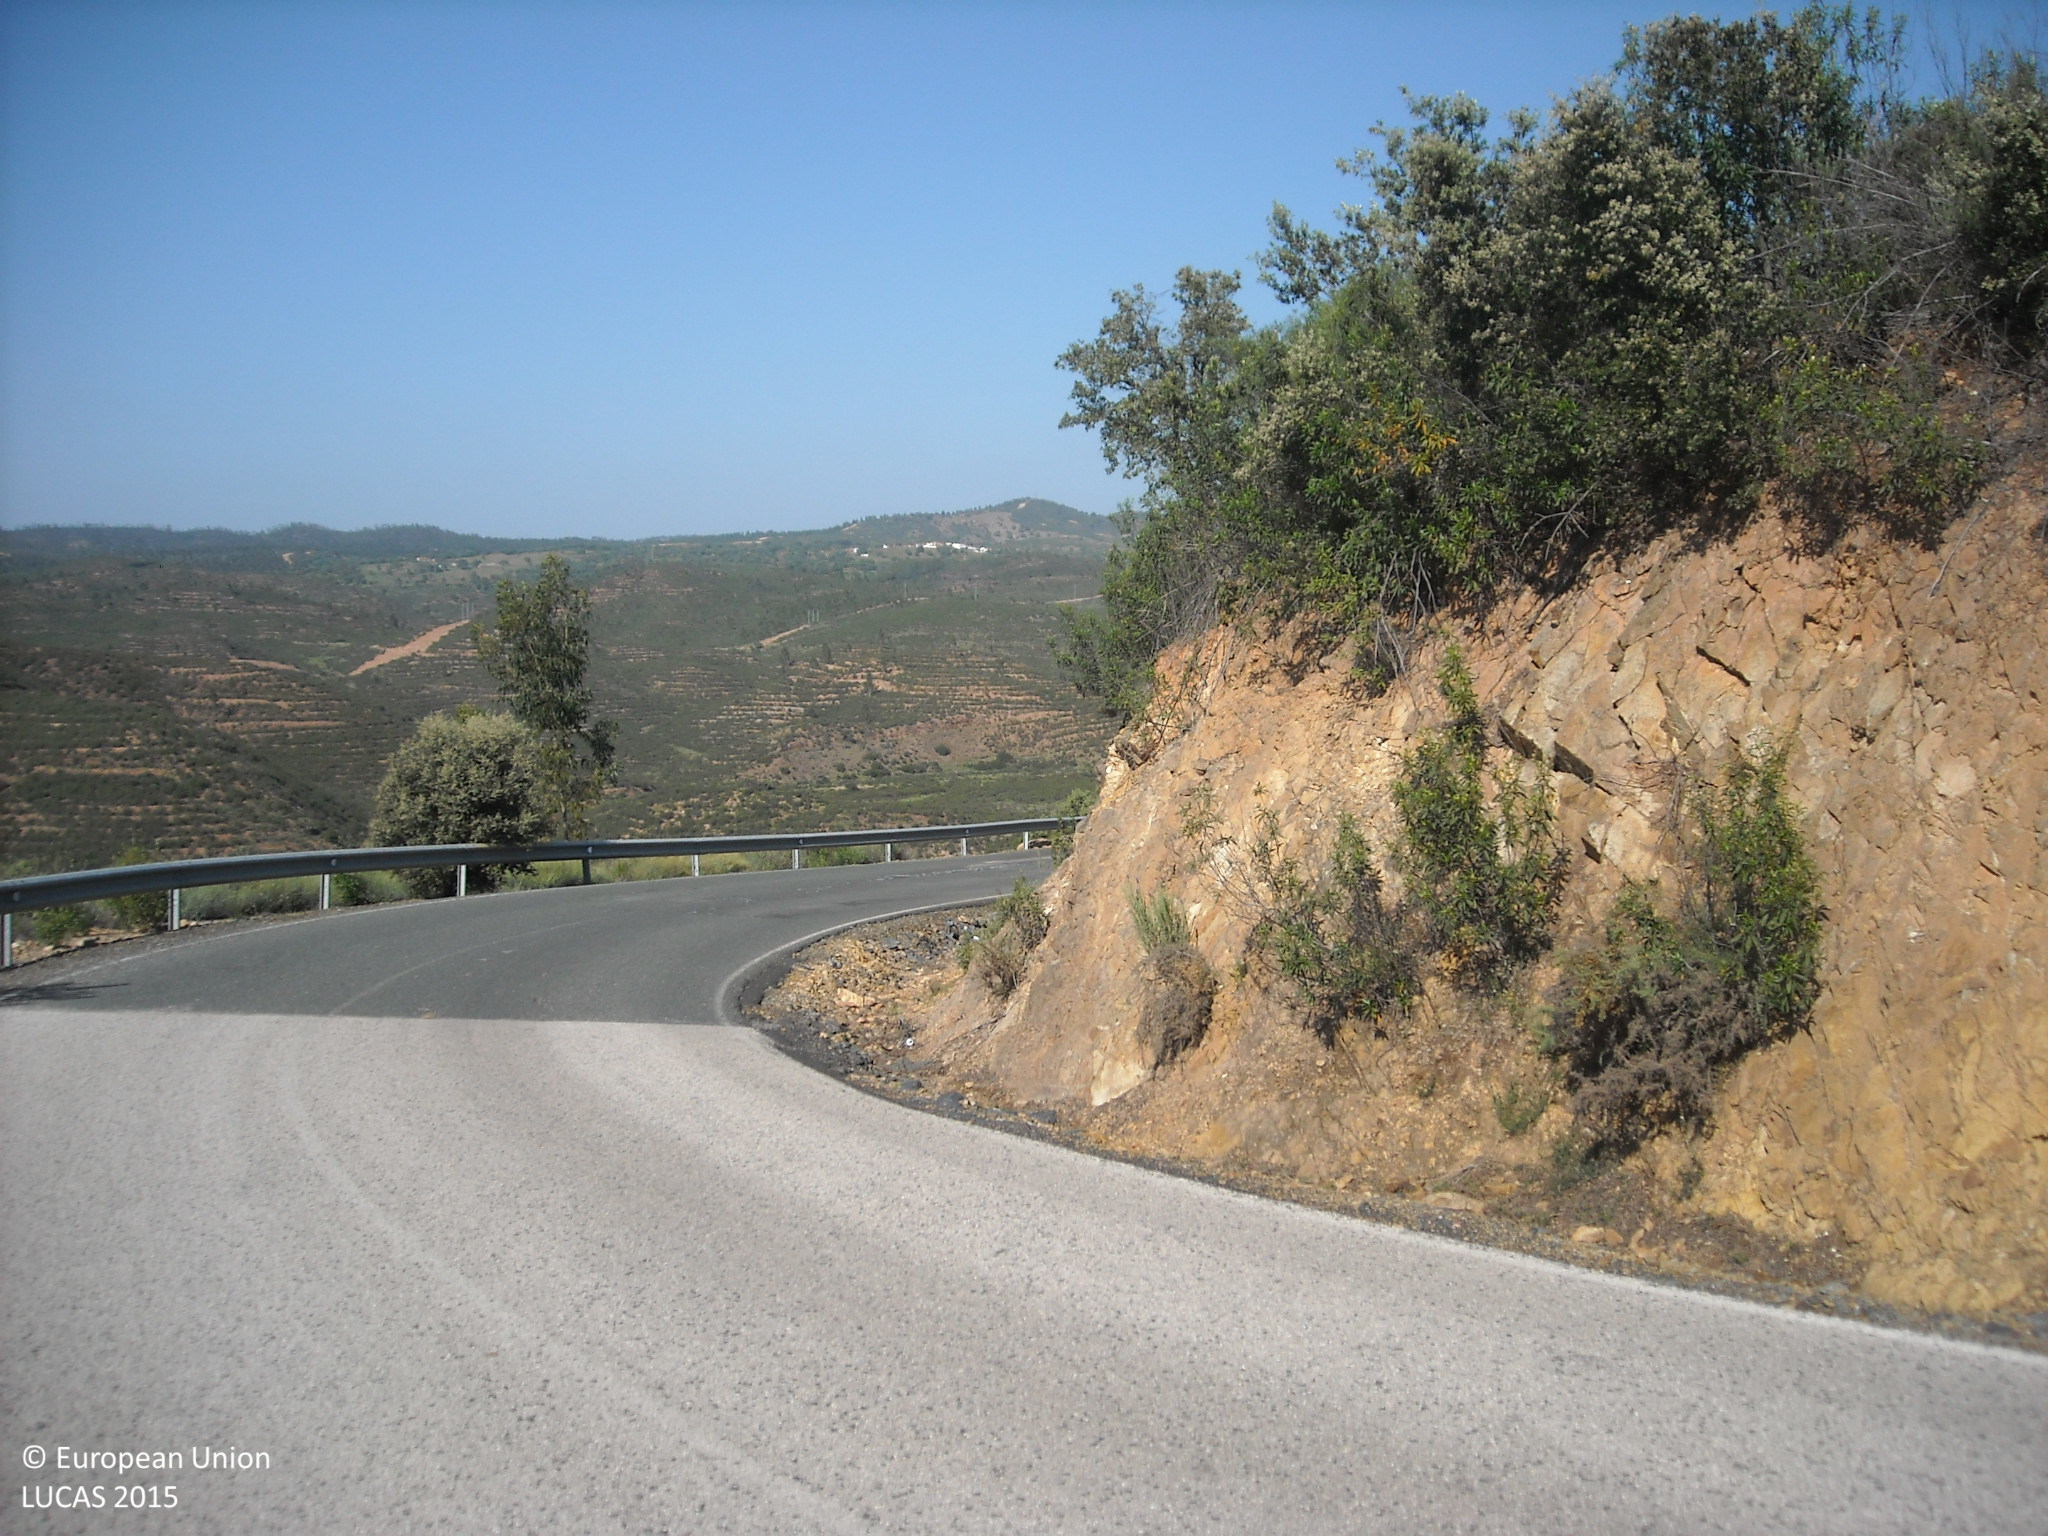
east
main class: Shrubland
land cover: Shrubland without tree cover
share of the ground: > 75 %
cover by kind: shrubs 75 %, herbaceous plants 25 %
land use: Semi-natural and natural areas not in use
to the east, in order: Shrubland without tree cover
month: April
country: ES
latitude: 37.6458
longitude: -6.4822
